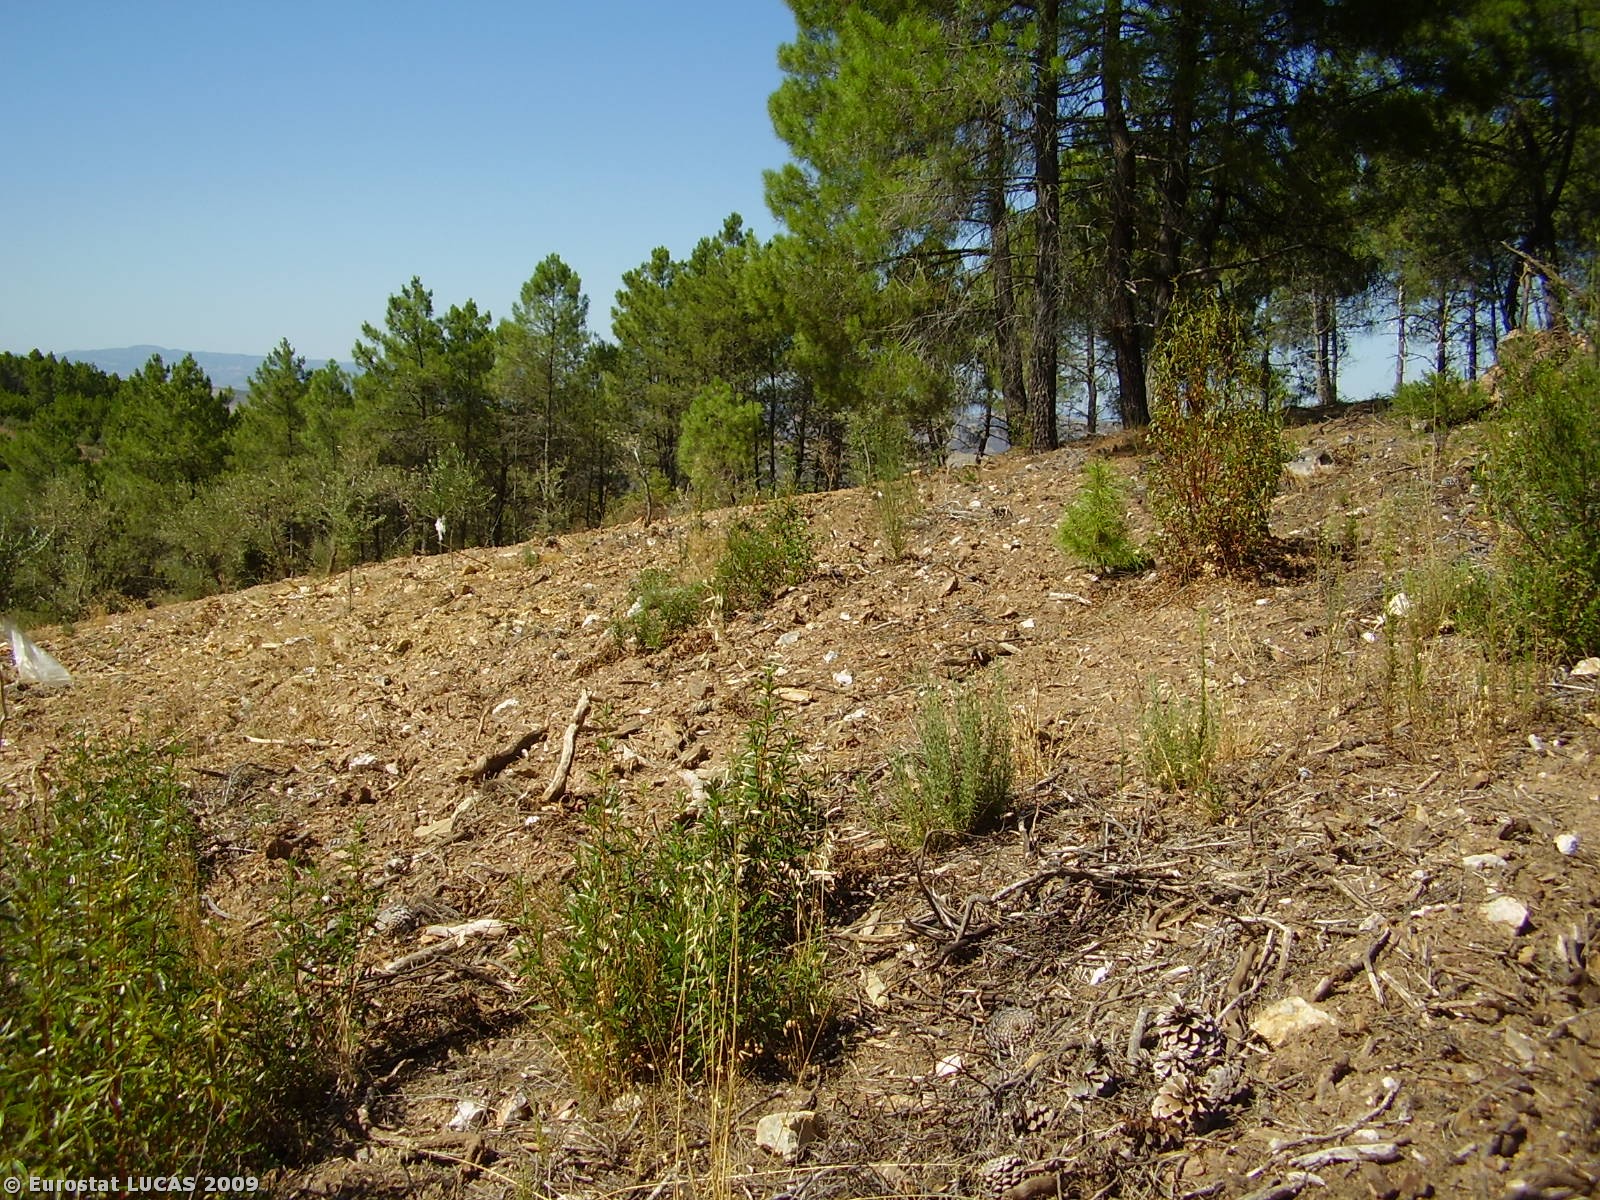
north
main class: Shrubland
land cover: Shrubland with sparse tree cover
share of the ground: > 75 %
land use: Fallow land
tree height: > 5 m
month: August
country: PT
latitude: 41.2217
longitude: -6.7934
